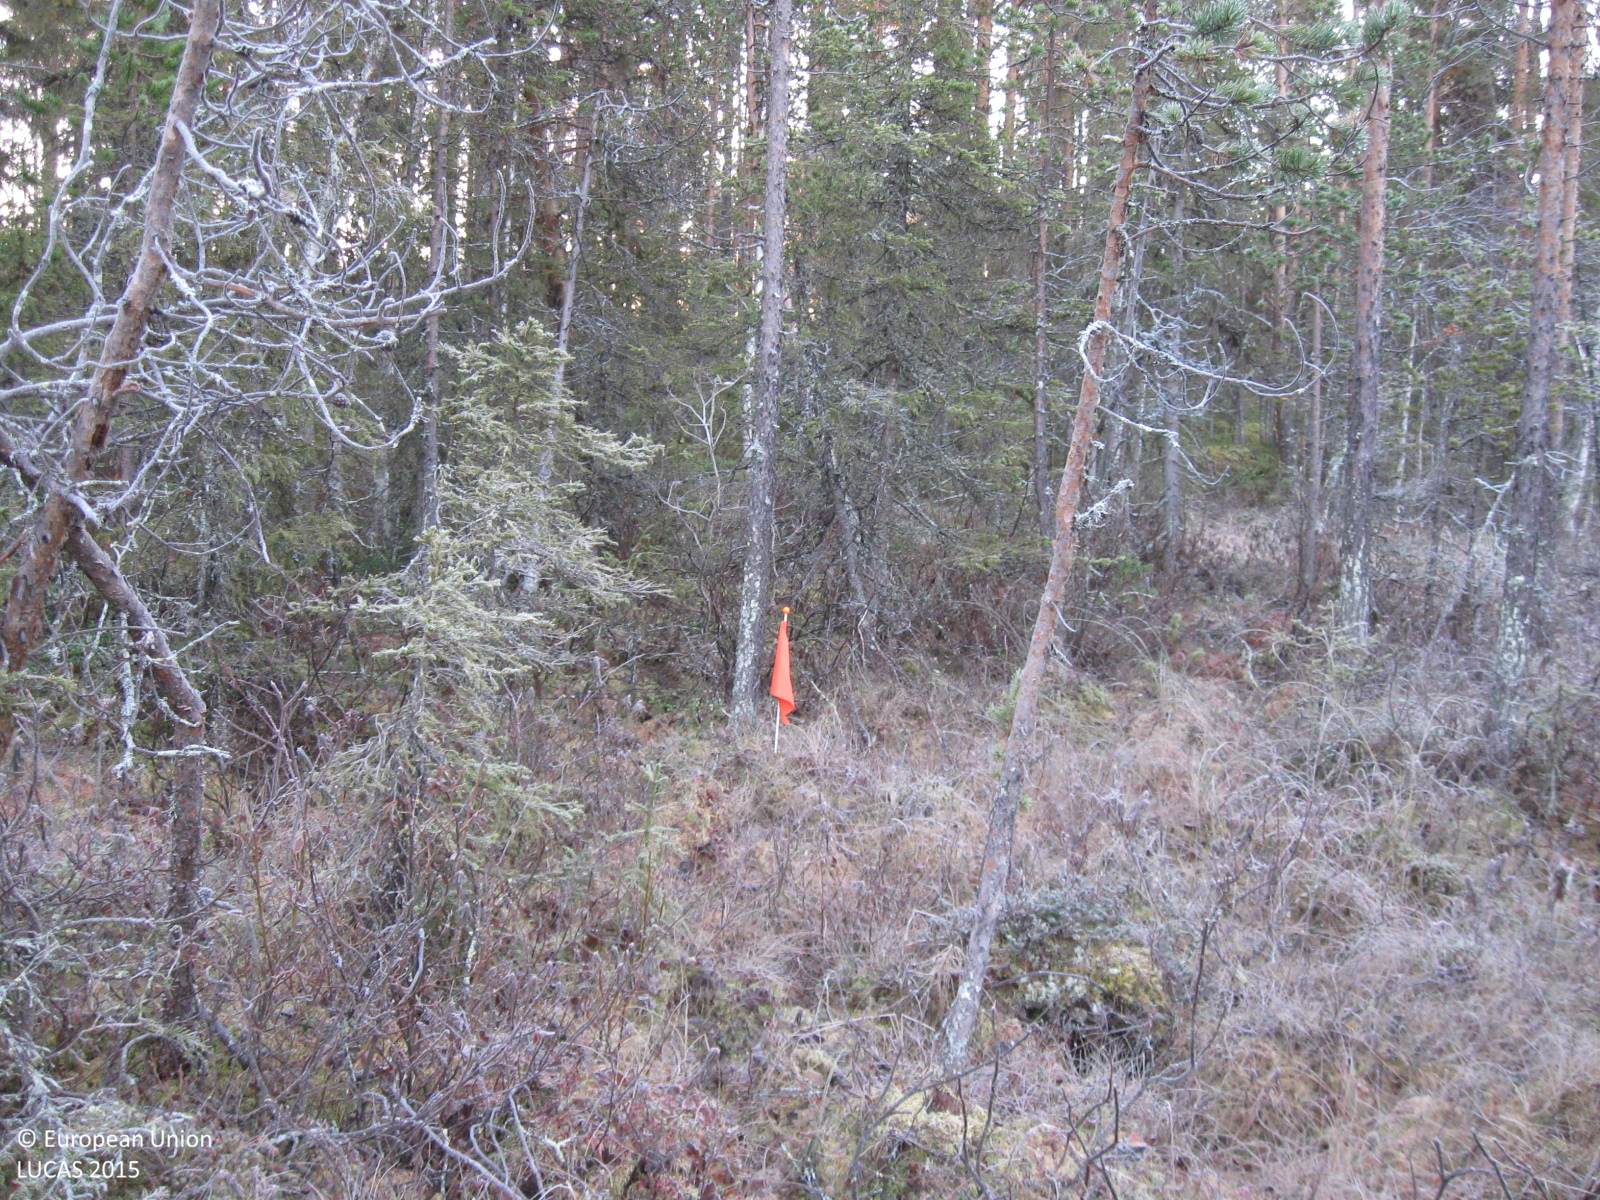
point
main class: Woodland
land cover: Pine dominated coniferous woodland
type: mire and swamp forests
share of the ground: 50 - 75 %
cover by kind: coniferous forest trees 60 %, broadleaved forest trees 10 %, shrubs 10 %, herbaceous plants 10 %, lichens and mosses 10 %
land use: Forestry
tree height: > 5 m
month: October
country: SE
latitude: 66.4697
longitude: 20.9354
